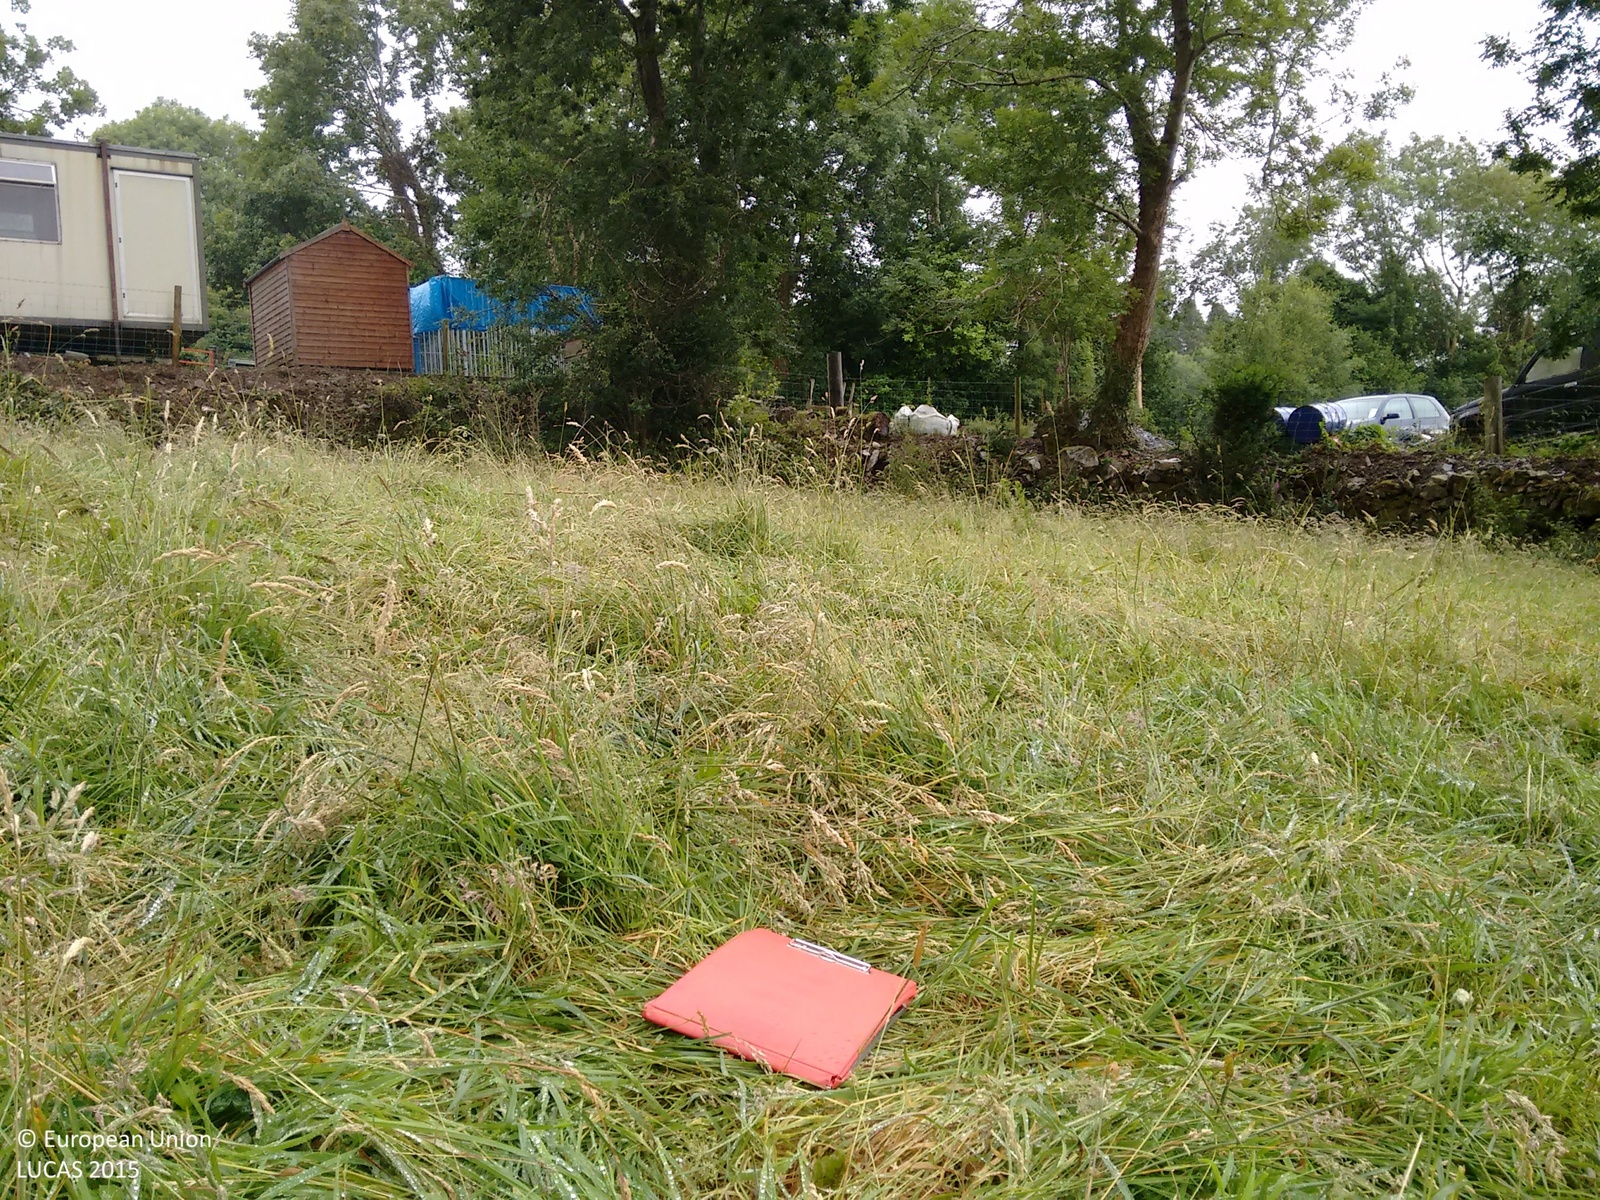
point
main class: Grassland
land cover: Grassland without tree/shrub cover
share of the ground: > 75 %
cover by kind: herbaceous plants 100 %
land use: Agriculture (excluding fallow land and kitchen gardens)
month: July
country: IE
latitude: 52.9305
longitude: -6.2923
